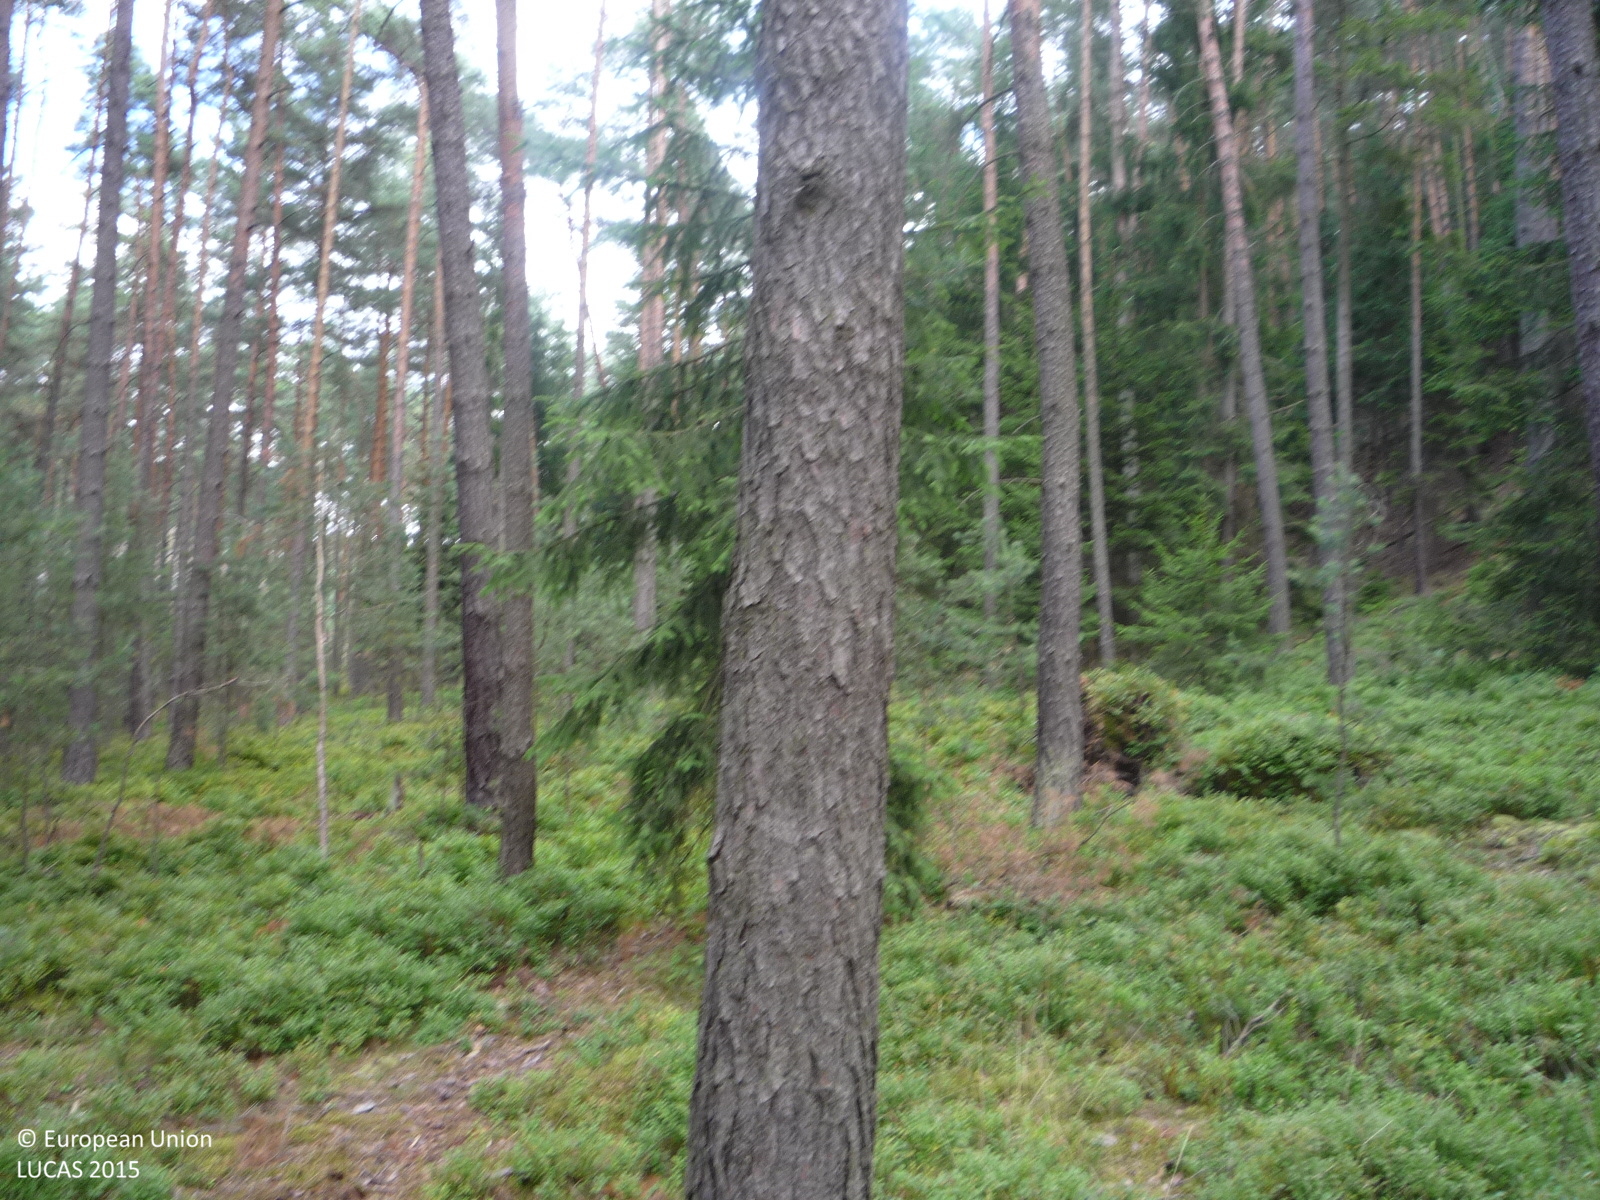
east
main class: Woodland
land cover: Pine dominated coniferous woodland
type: hemiboreal forest and nemoral coniferous forest and mixed broadleaved-coniferous forest
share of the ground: > 75 %
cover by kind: coniferous forest trees 90 %, herbaceous plants 10 %
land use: Forestry
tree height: > 5 m
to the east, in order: Pine dominated coniferous woodland; Other coniferous woodland; Other bare soil
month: July
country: CZ
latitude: 50.5197
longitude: 14.6989
